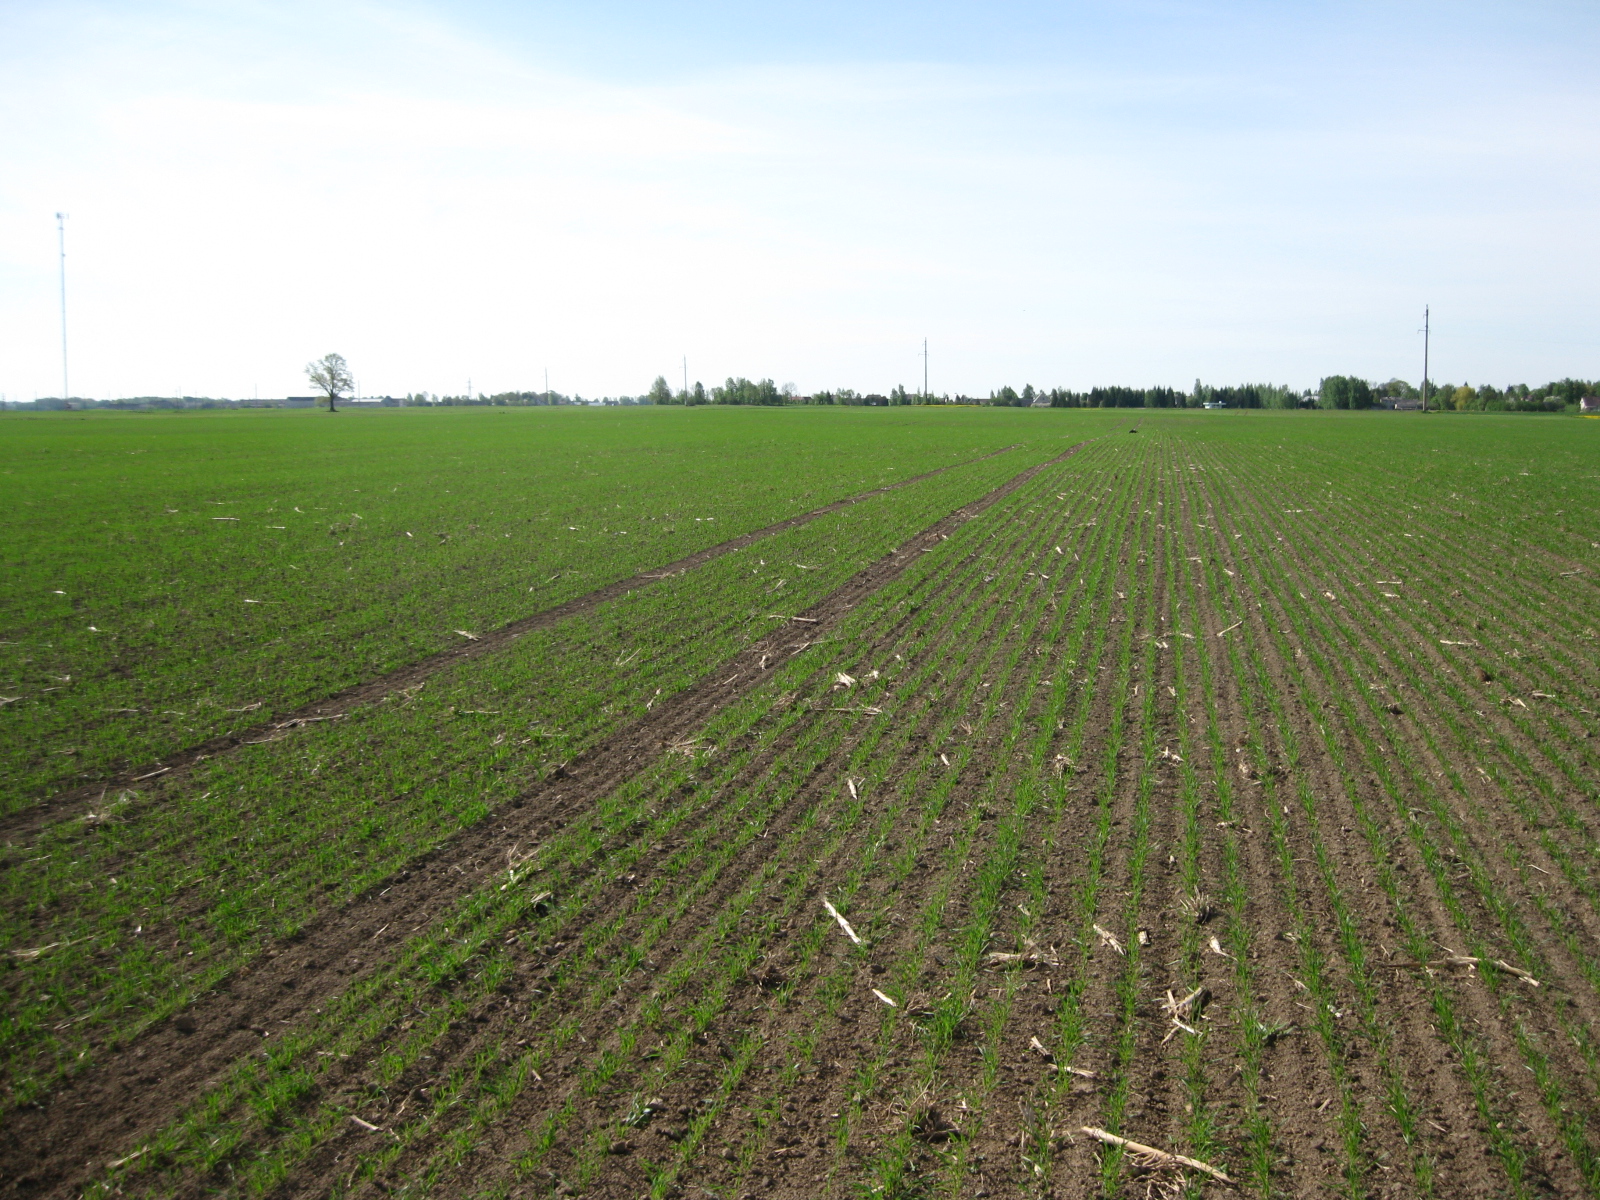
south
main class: Cropland
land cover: Common wheat
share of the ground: < 10 %
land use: Agriculture (excluding fallow land and kitchen gardens)
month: May
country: LT
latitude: 56.1769
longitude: 24.2183
